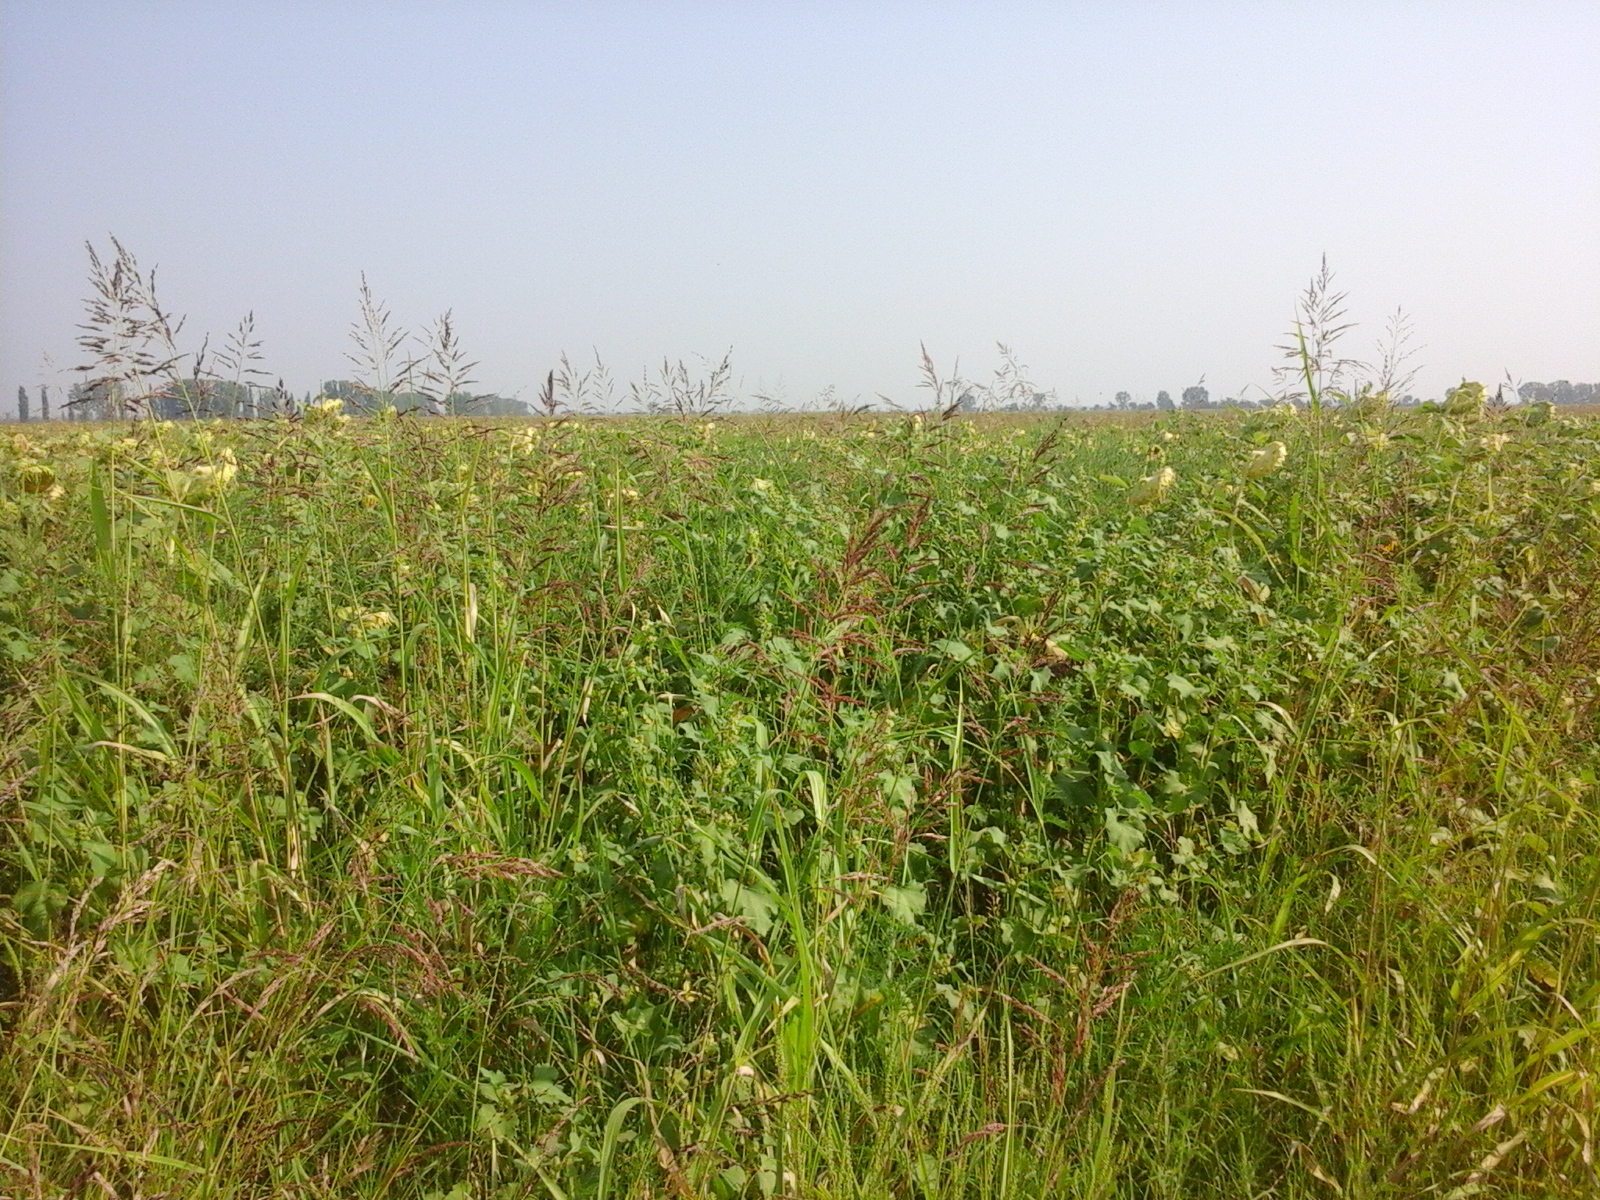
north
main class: Cropland
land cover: Sunflower
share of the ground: > 75 %
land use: Agriculture (excluding fallow land and kitchen gardens)
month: August
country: RO
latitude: 44.0381
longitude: 23.4383
